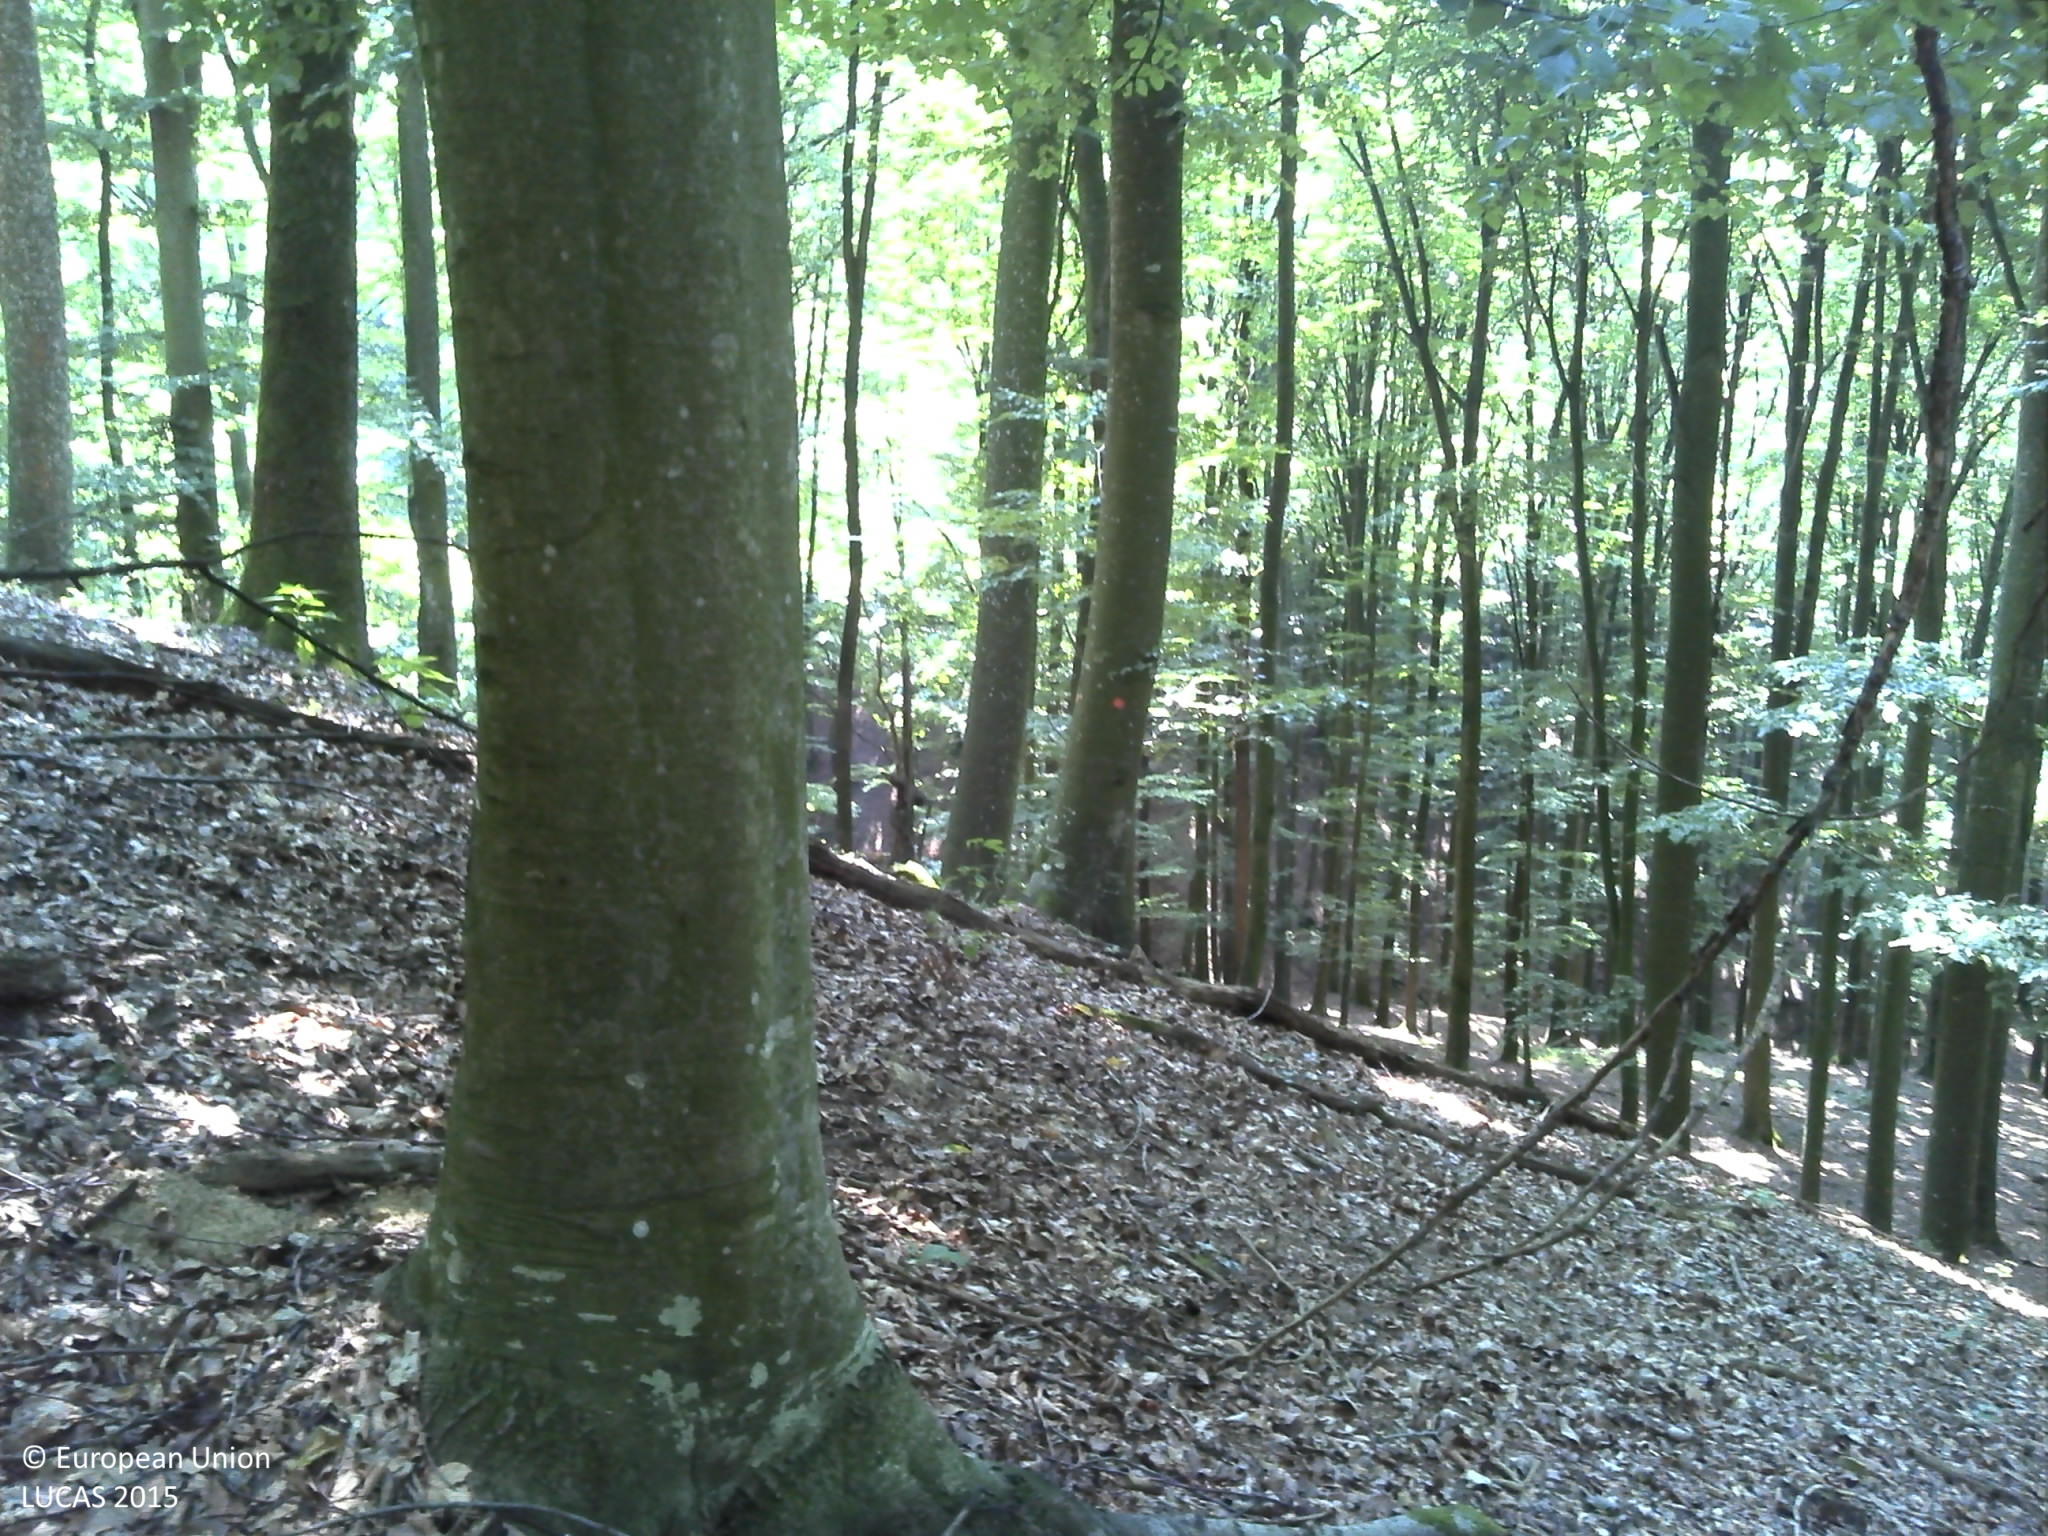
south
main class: Woodland
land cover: Broadleaved woodland
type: beech forest
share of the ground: > 75 %
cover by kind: broadleaved forest trees 100 %
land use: Forestry
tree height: > 5 m
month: August
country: HR
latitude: 45.5921
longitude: 16.8060
